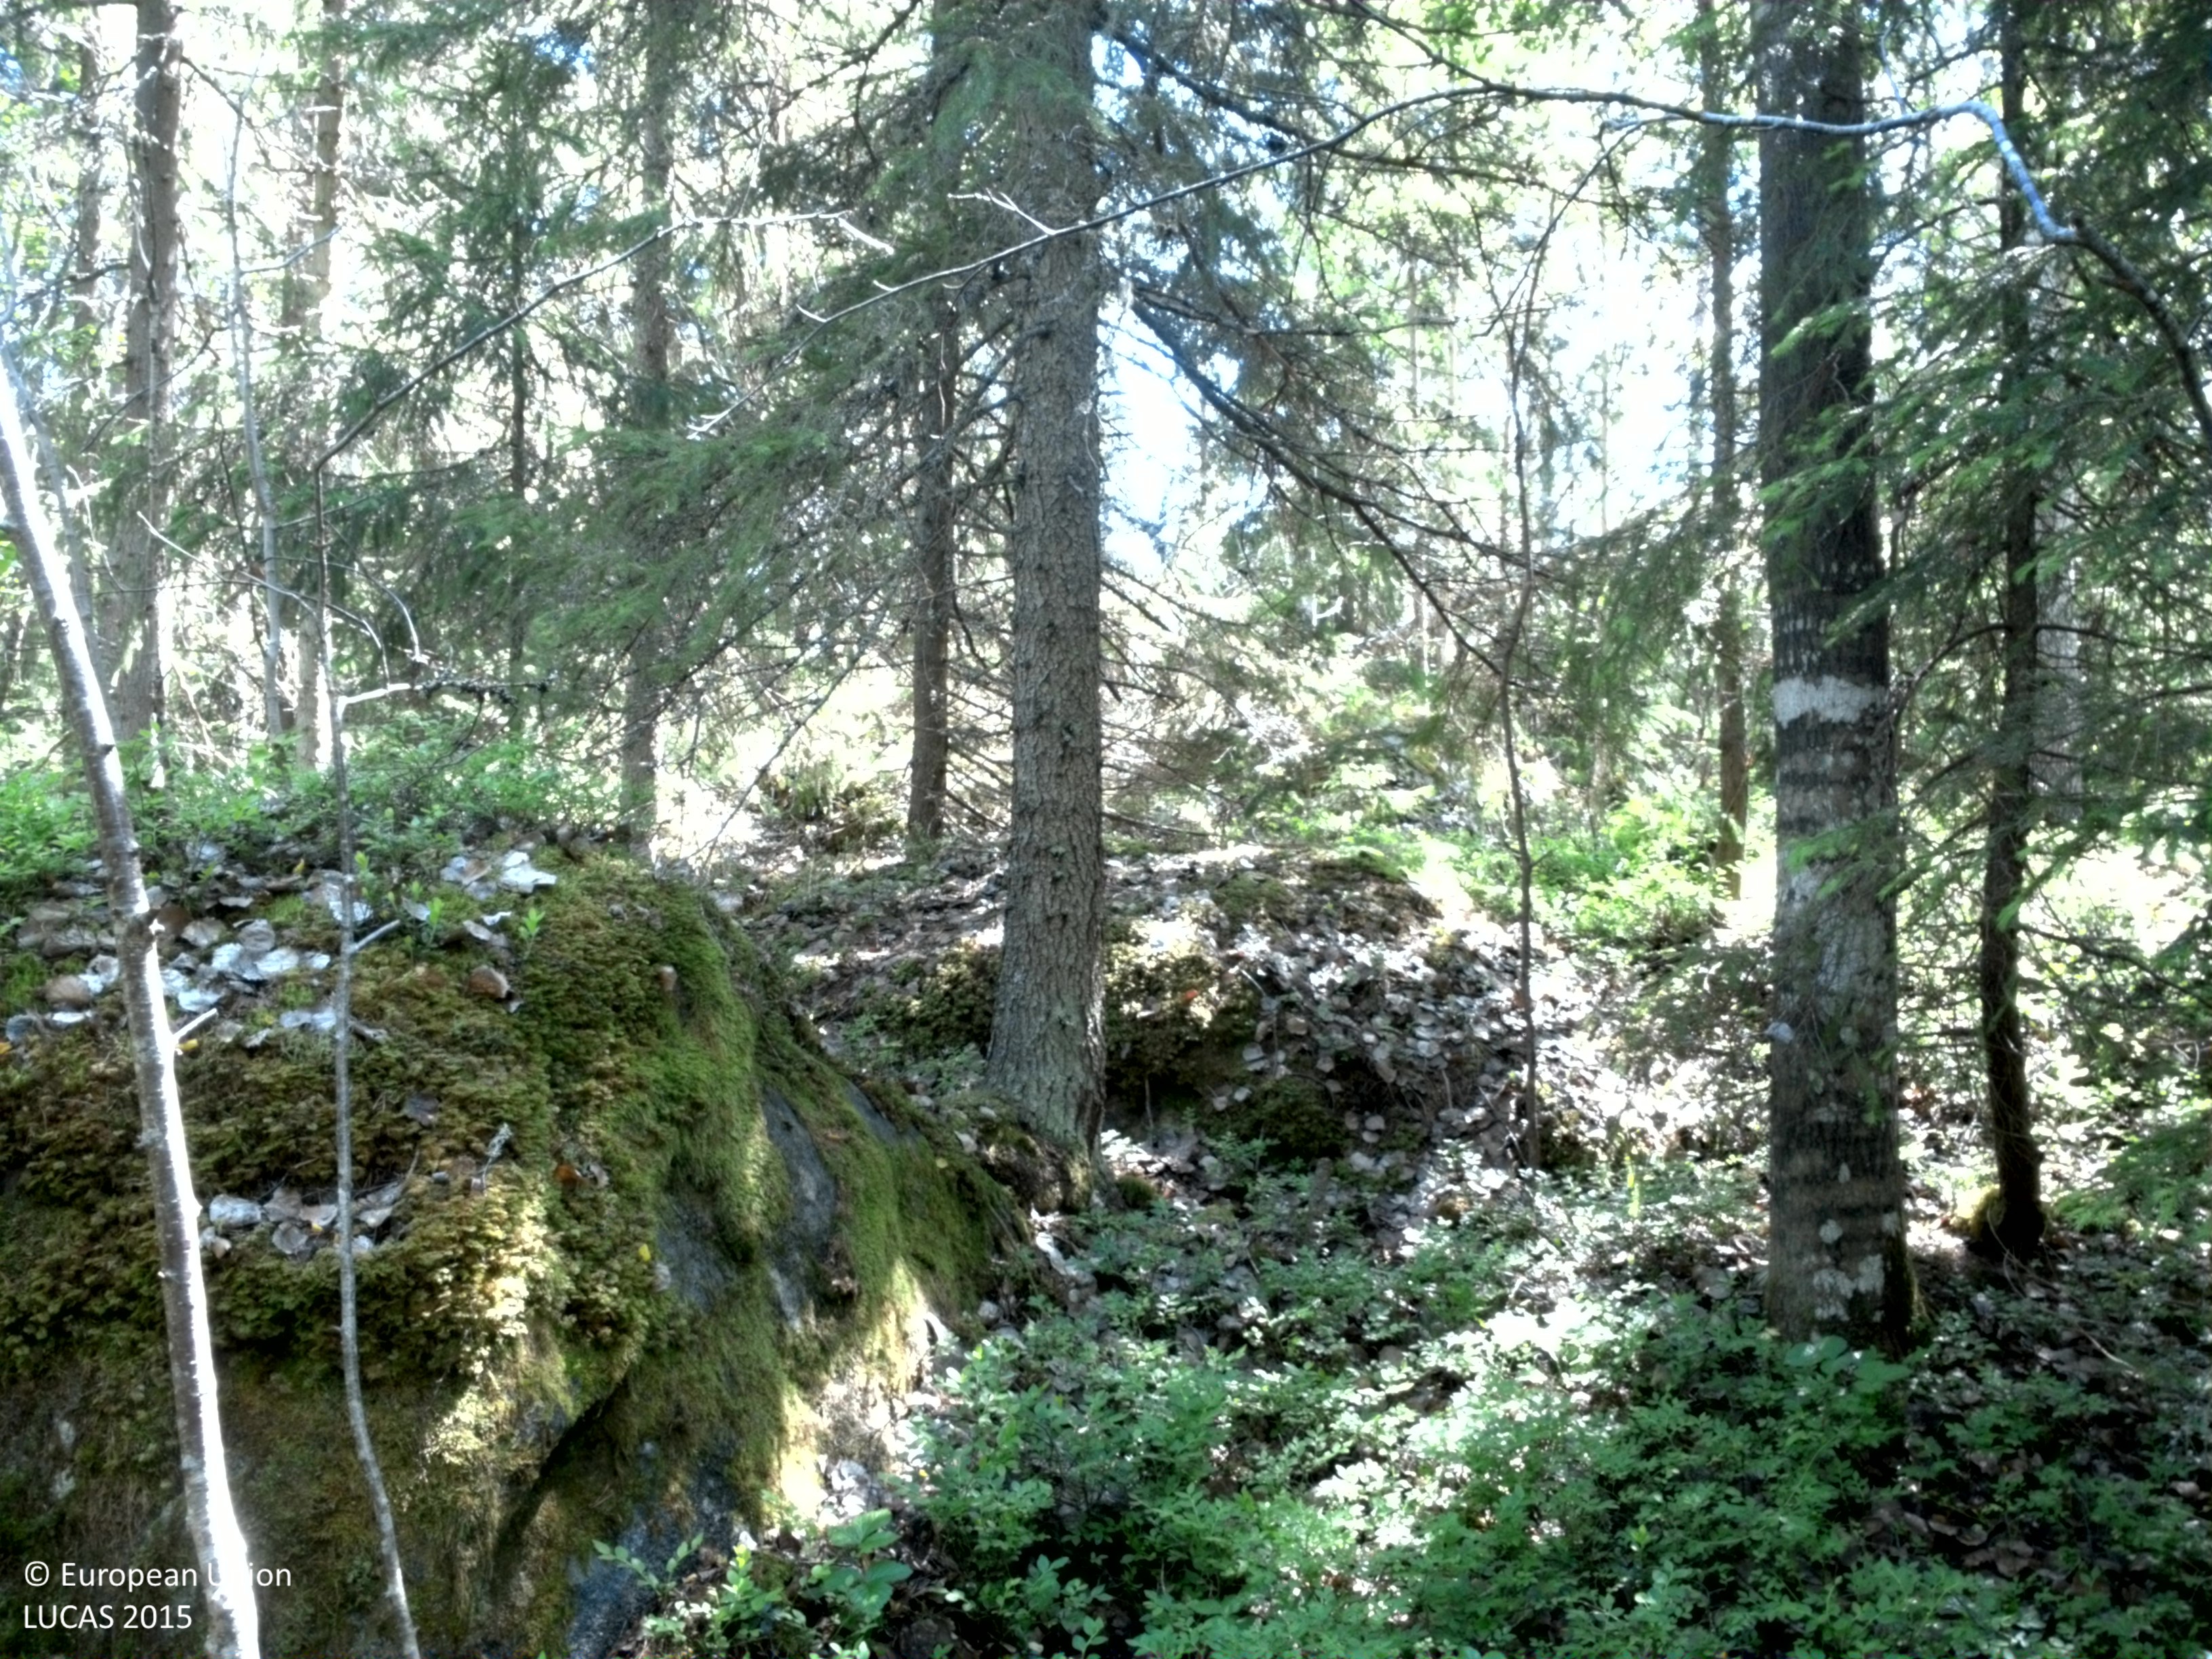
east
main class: Woodland
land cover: Spruce dominated mixed woodland
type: boreal forest
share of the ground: 50 - 75 %
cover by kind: coniferous forest trees 45 %, lichens and mosses 25 %, broadleaved forest trees 15 %, herbaceous plants 15 %
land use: Forestry
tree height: > 5 m
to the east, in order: Spruce dominated mixed woodland; Broadleaved woodland; Spruce dominated mixed woodland; Grassland with sparse tree/shrub cover; Electric lines; Broadleaved woodland; Spruce dominated coniferous woodland; Spruce dominated mixed woodland
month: June
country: SE
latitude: 60.1140
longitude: 18.6521
